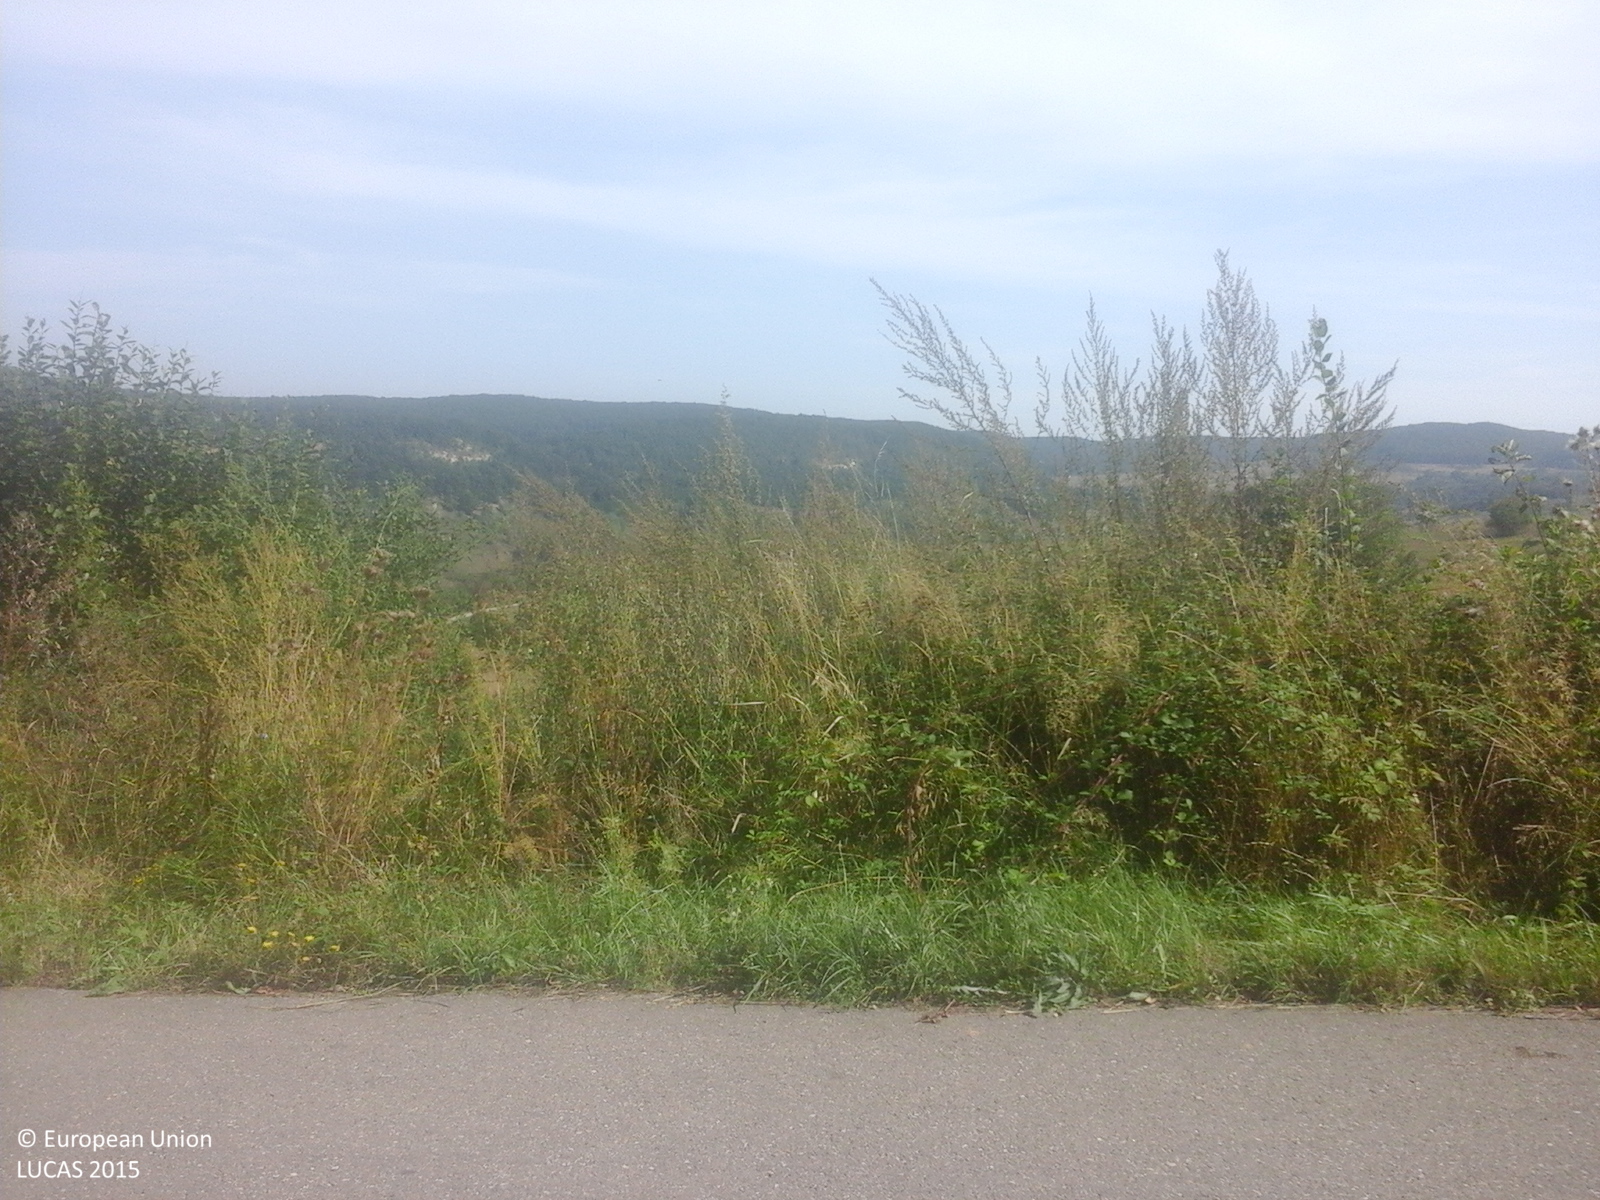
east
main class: Woodland
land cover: Broadleaved woodland
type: acidophilous oak and oak-birch forest
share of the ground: > 75 %
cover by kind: broadleaved forest trees 100 %
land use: Forestry
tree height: > 5 m
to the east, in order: Broadleaved woodland; Grass margins; Paved roads, cycling and walking lanes; Spontaneously vegetated surfaces; Grassland without tree/shrub cover; Single bushes/trees; Grassland without tree/shrub cover; Other fruit trees and berries
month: September
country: RO
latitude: 46.9108
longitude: 23.2344
